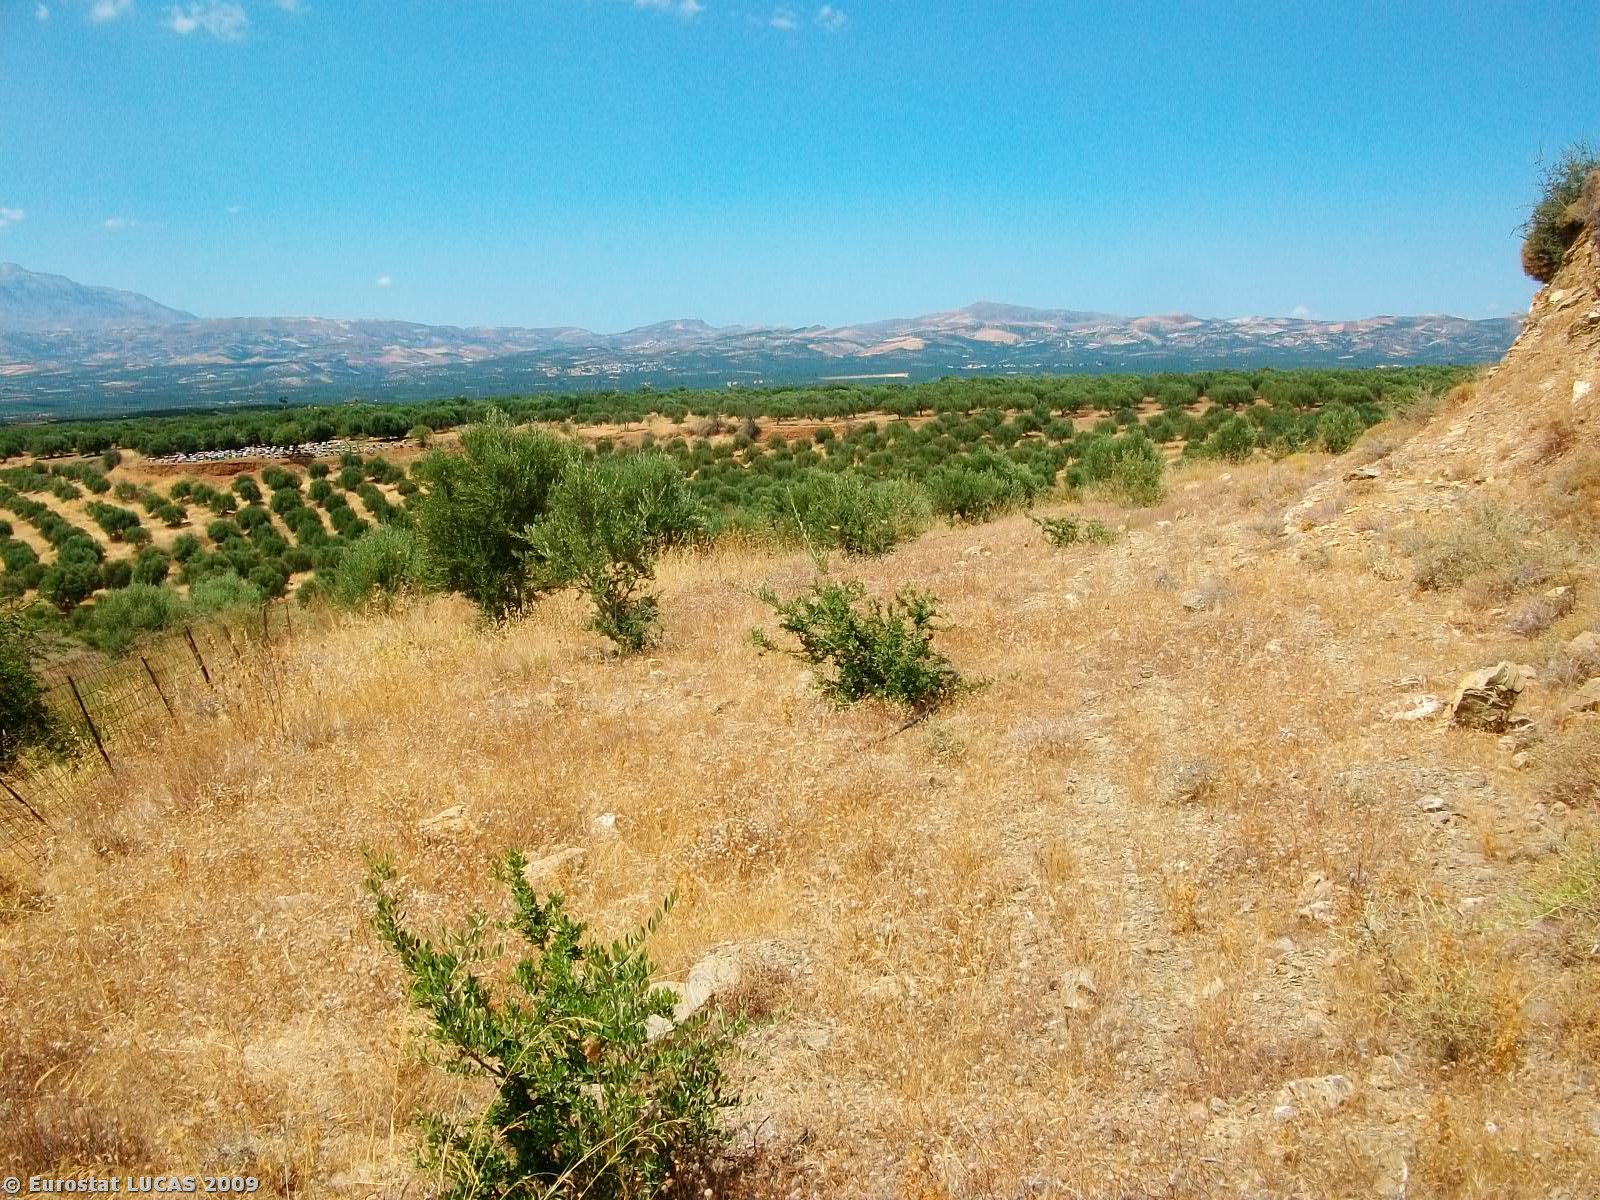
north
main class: Shrubland
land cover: Shrubland without tree cover
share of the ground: > 75 %
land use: Unused
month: July
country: GR
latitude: 34.9944
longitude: 25.0499
